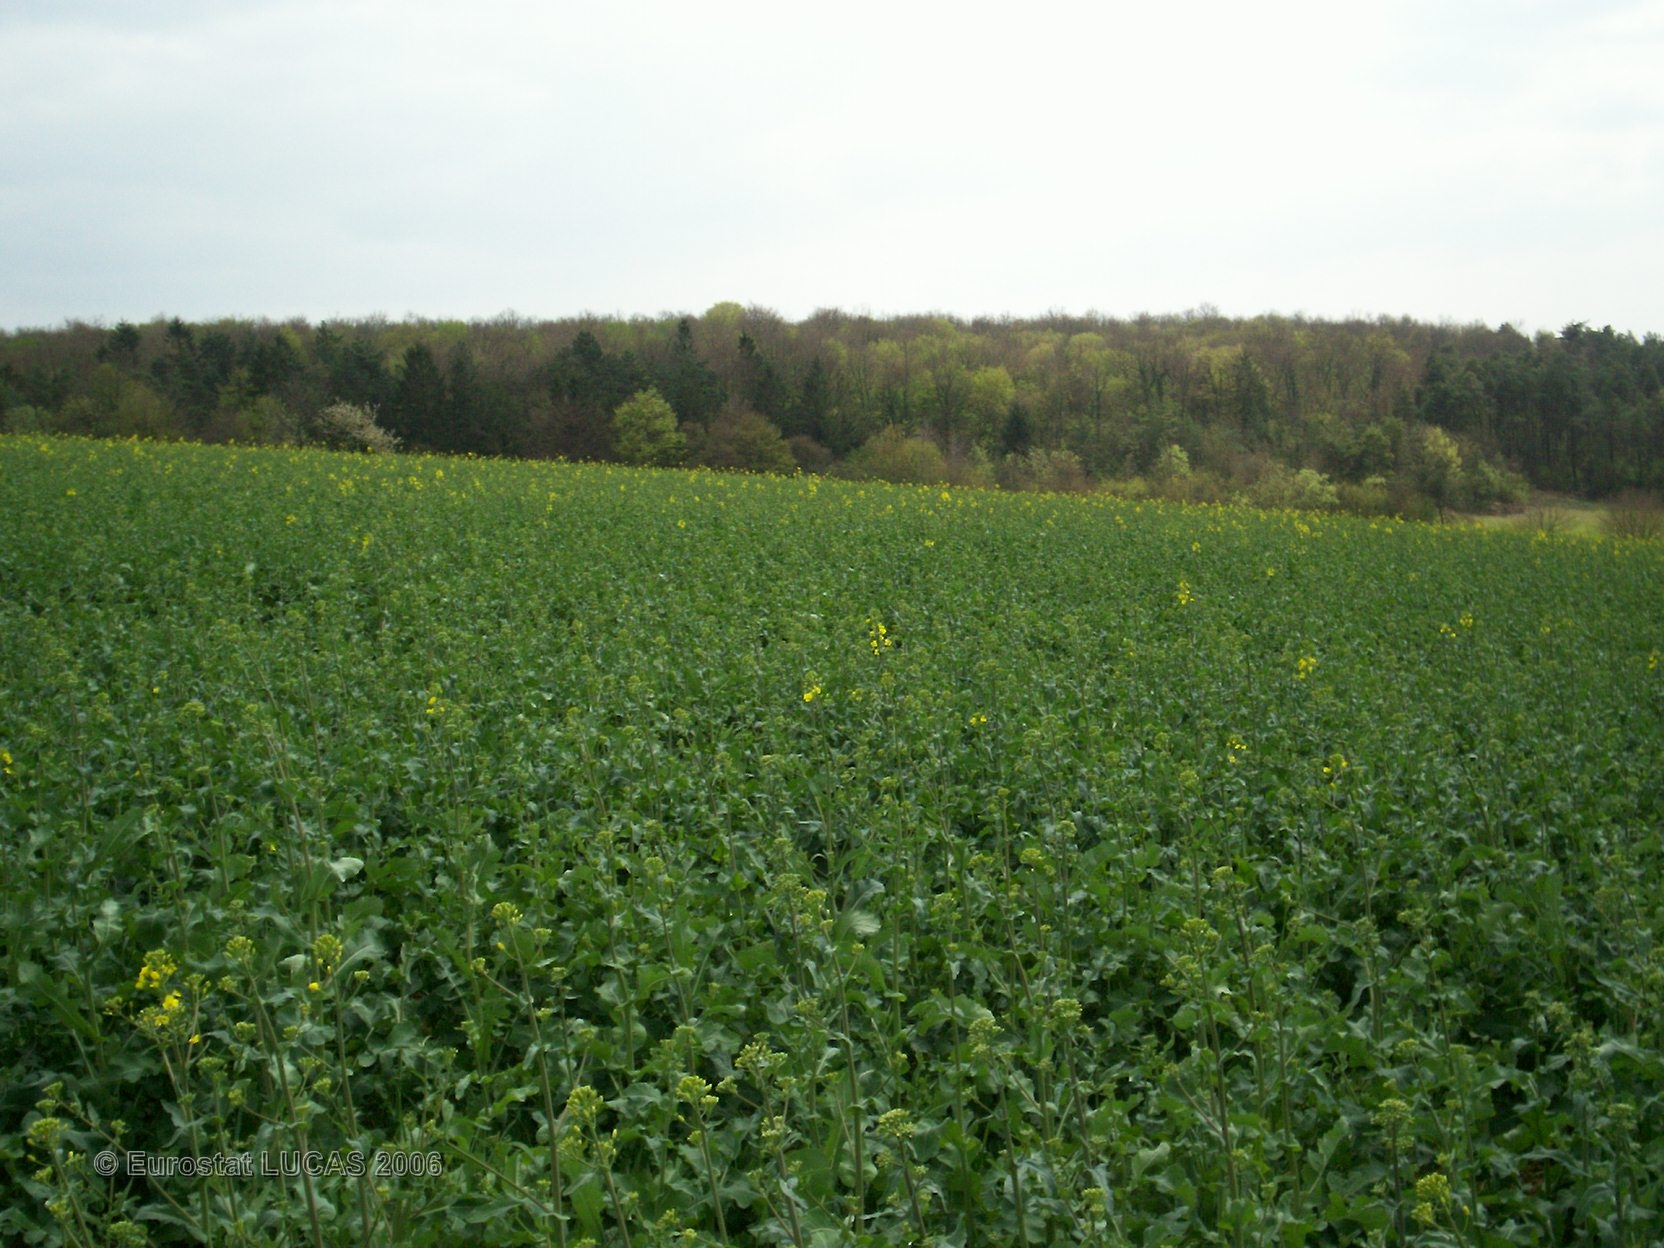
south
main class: Cropland
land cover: Rape and turnip rape
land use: Agriculture (excluding fallow land and kitchen gardens)
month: April
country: FR
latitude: 47.9431
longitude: 4.5226
